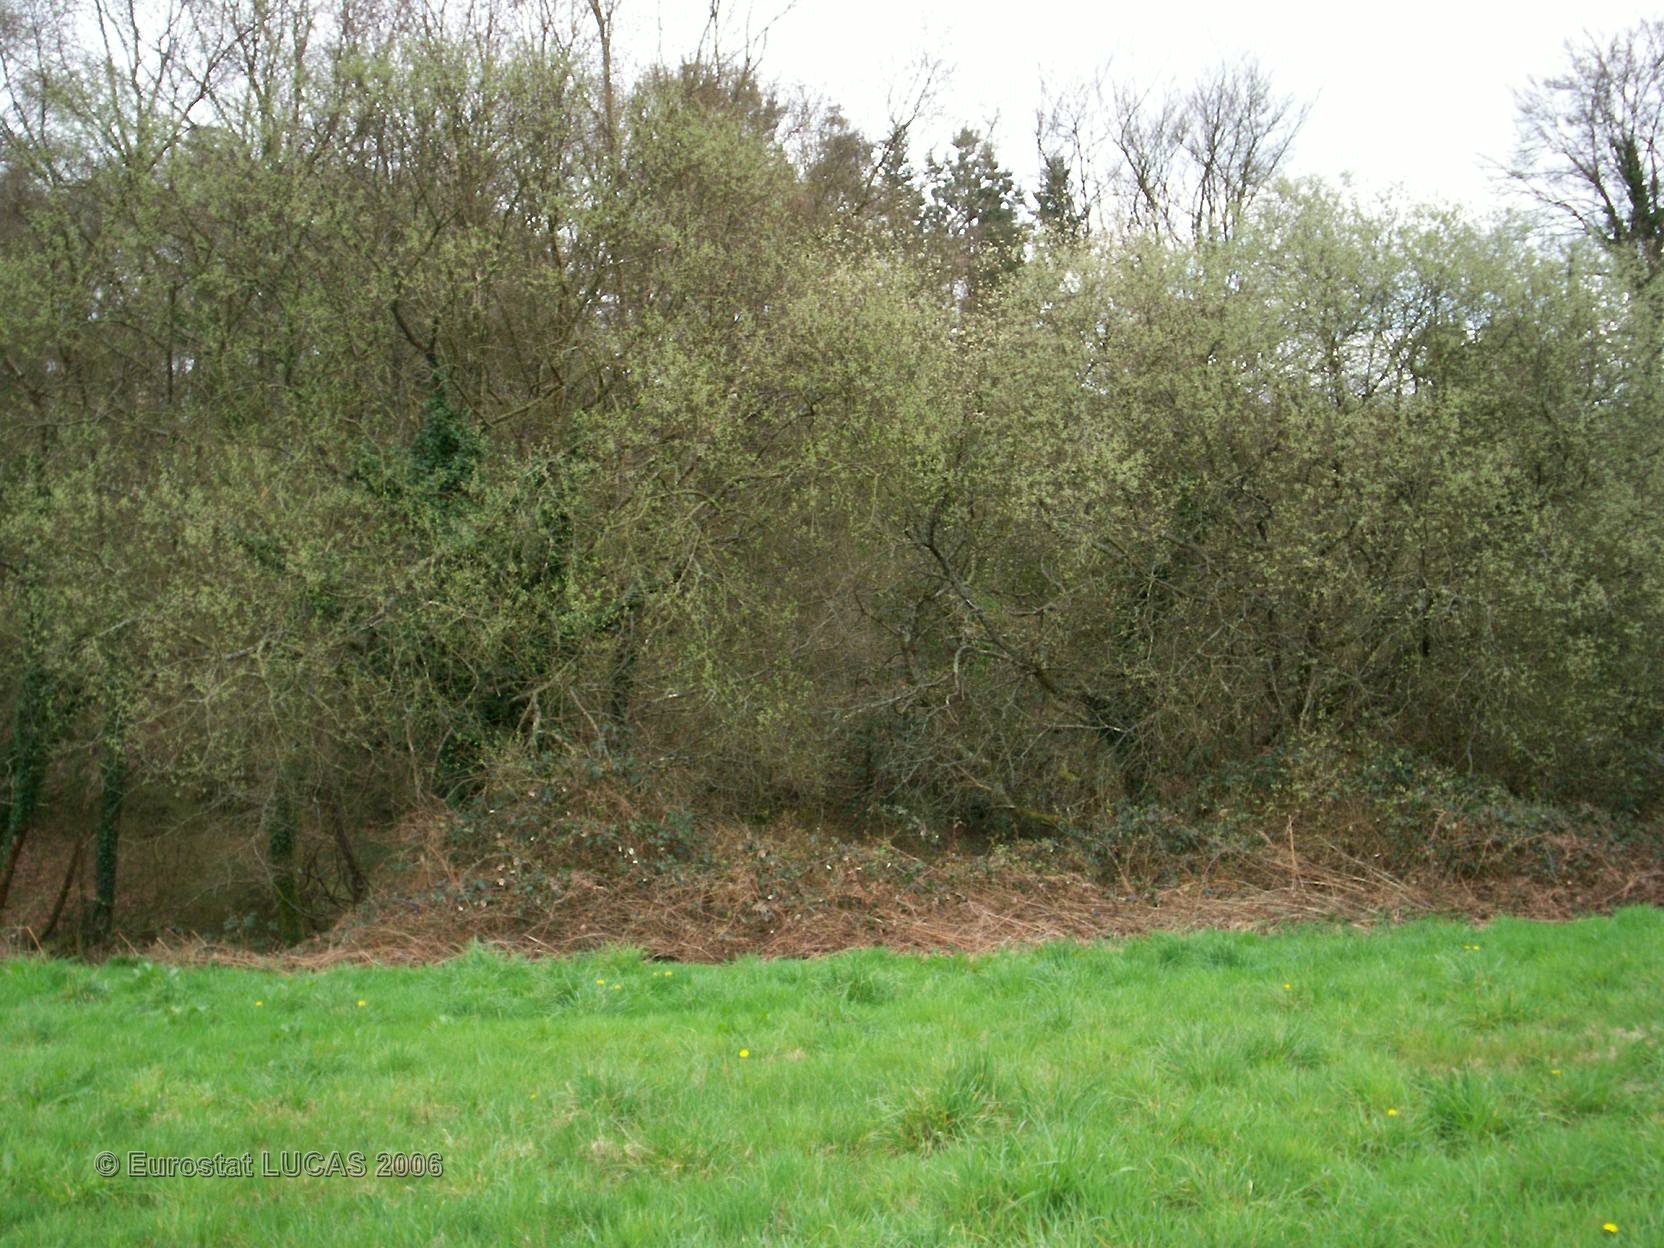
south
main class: Grassland
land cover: Grassland without tree/shrub cover
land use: Agriculture (excluding fallow land and kitchen gardens)
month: April
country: FR
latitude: 47.9883
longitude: -3.5166
